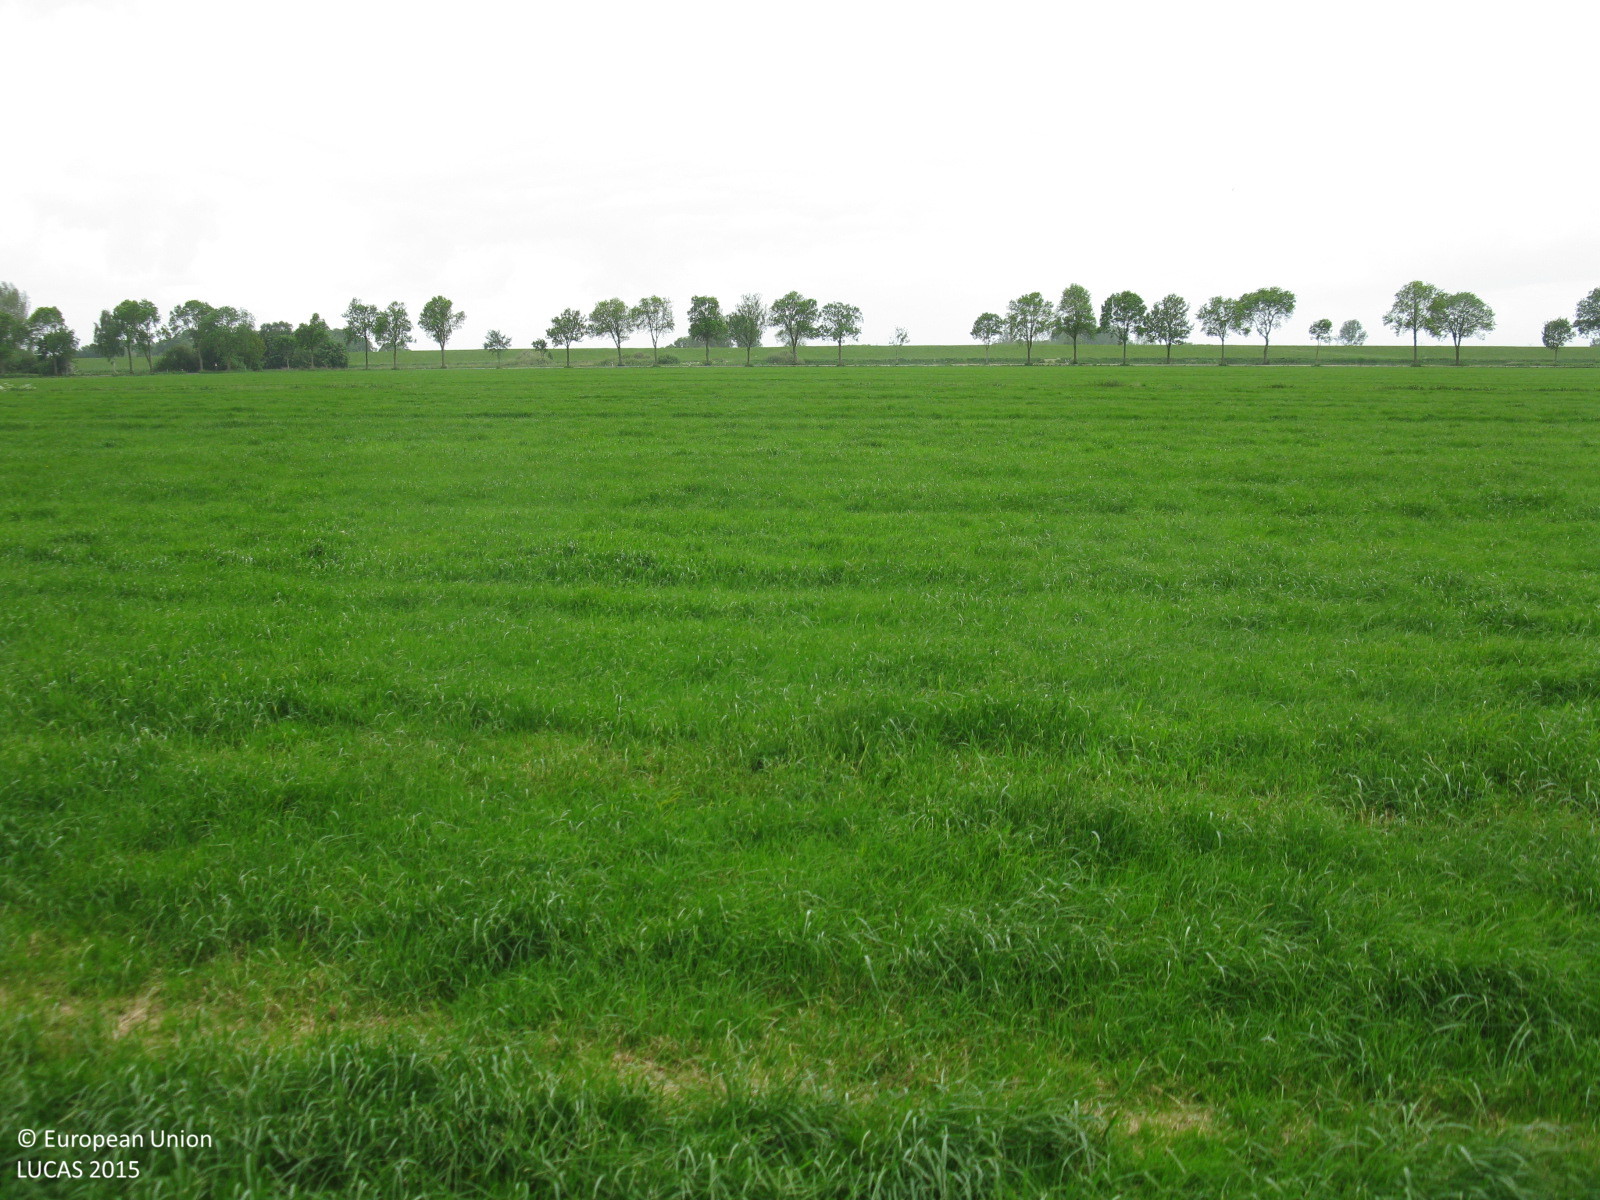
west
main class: Grassland
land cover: Grassland without tree/shrub cover
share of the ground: > 75 %
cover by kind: herbaceous plants 100 %
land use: Agriculture (excluding fallow land and kitchen gardens)
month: June
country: DE
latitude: 53.1220
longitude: 7.3856
